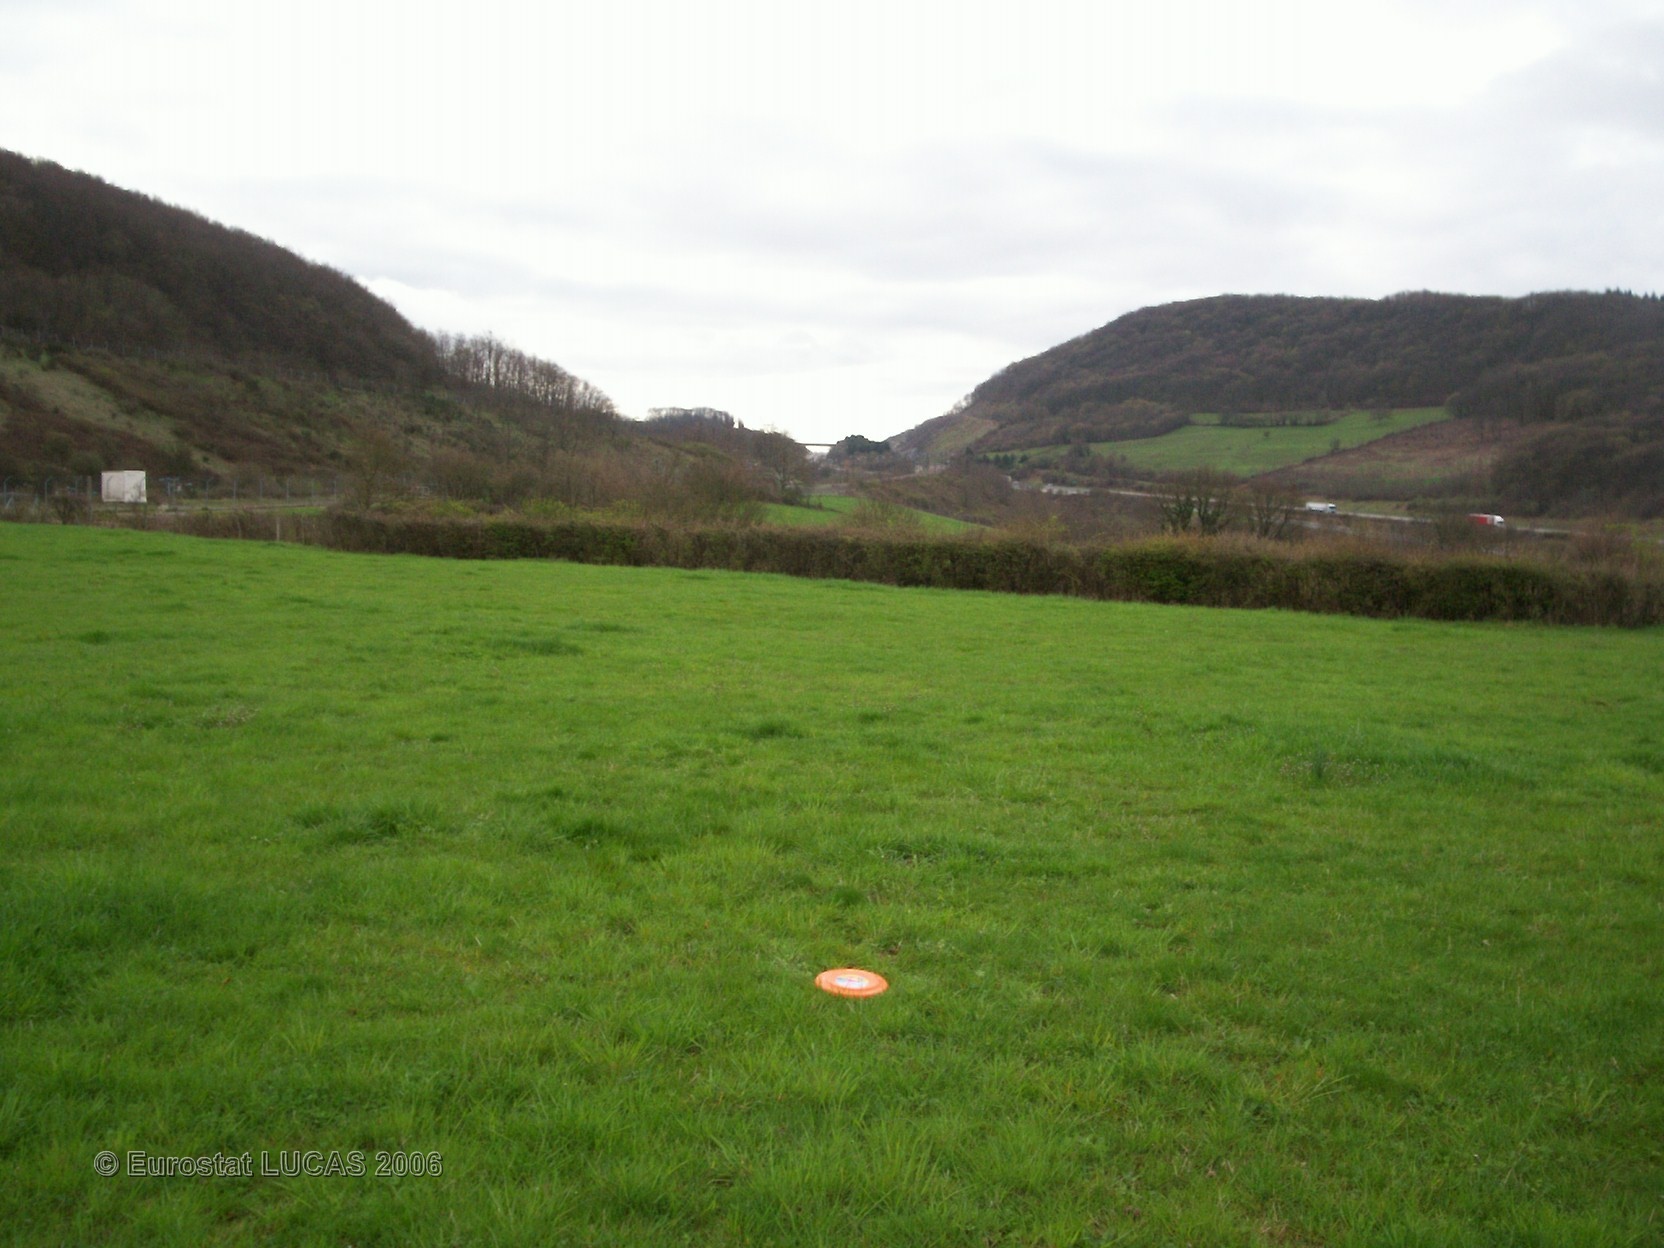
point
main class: Grassland
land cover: Grassland without tree/shrub cover
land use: Agriculture (excluding fallow land and kitchen gardens)
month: April
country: FR
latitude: 46.3982
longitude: 4.6564
